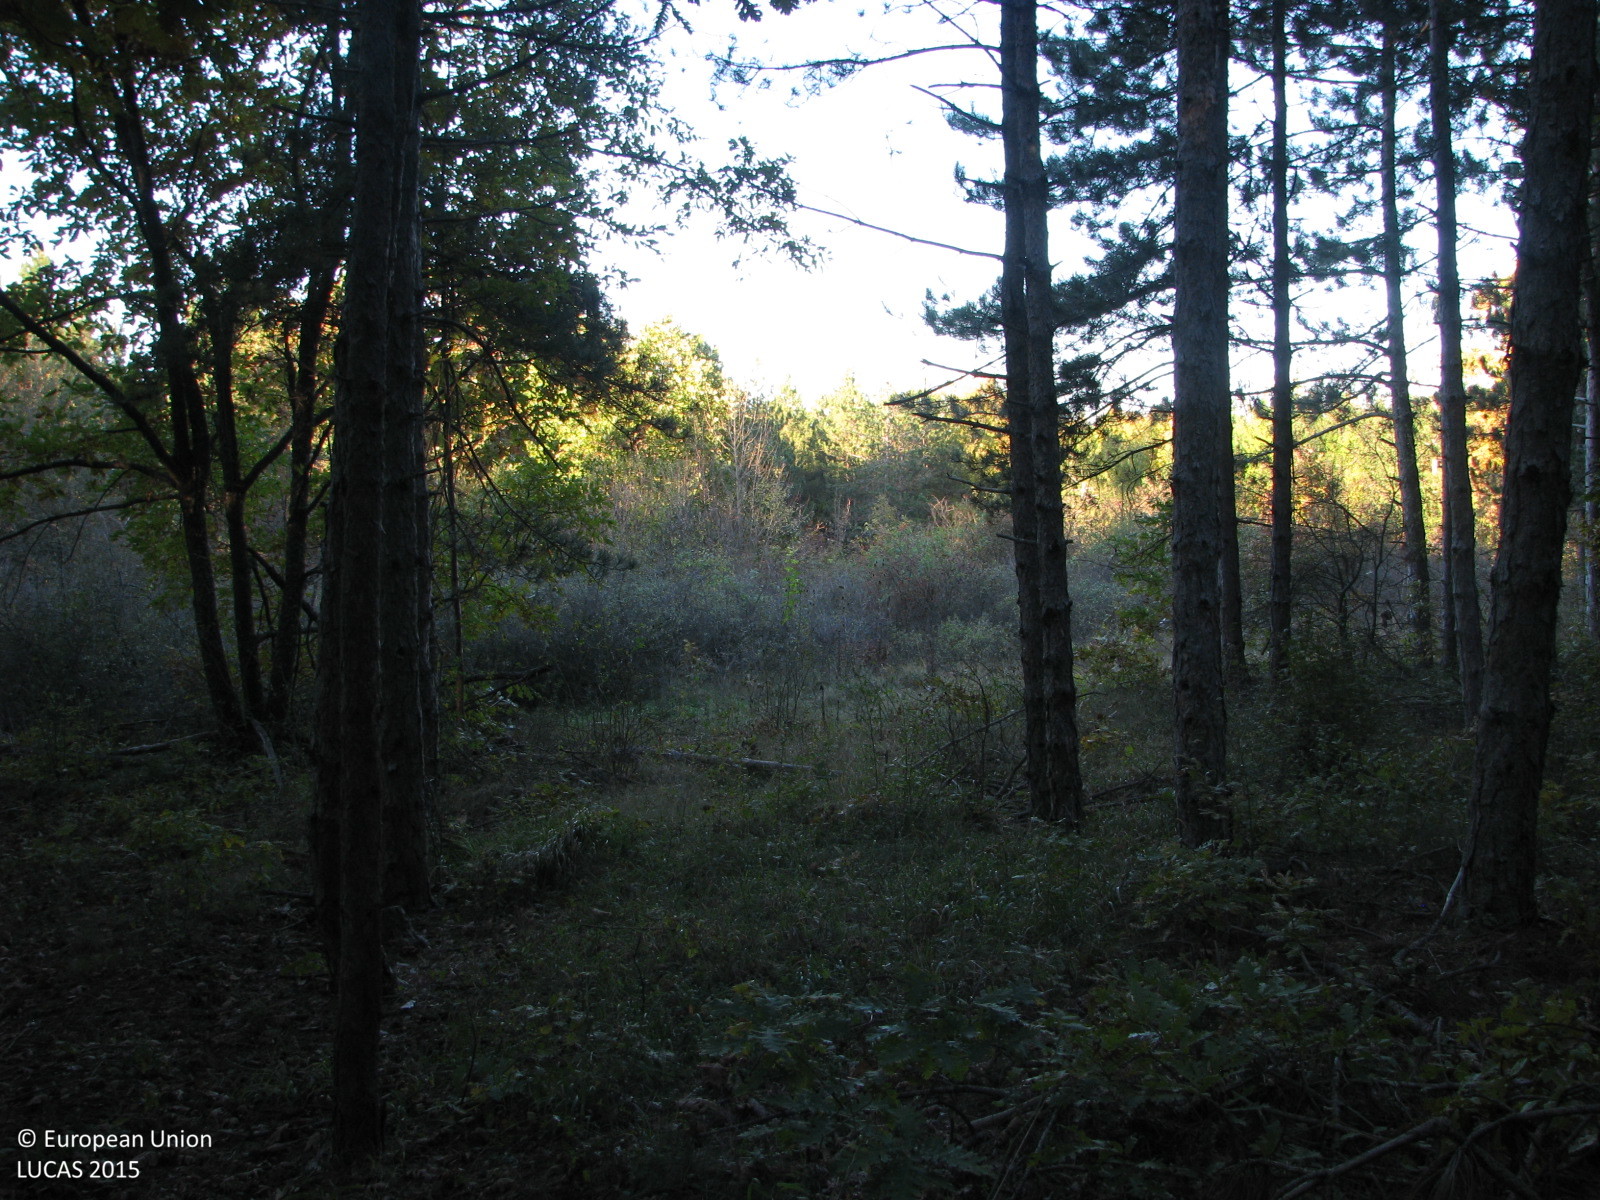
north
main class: Woodland
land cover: Pine dominated mixed woodland
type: hemiboreal forest and nemoral coniferous forest and mixed broadleaved-coniferous forest
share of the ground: > 75 %
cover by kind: coniferous forest trees 60 %, broadleaved forest trees 25 %, herbaceous plants 10 %, shrubs 5 %
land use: Forestry
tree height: > 5 m
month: November
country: BG
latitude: 42.1417
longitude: 26.9038
